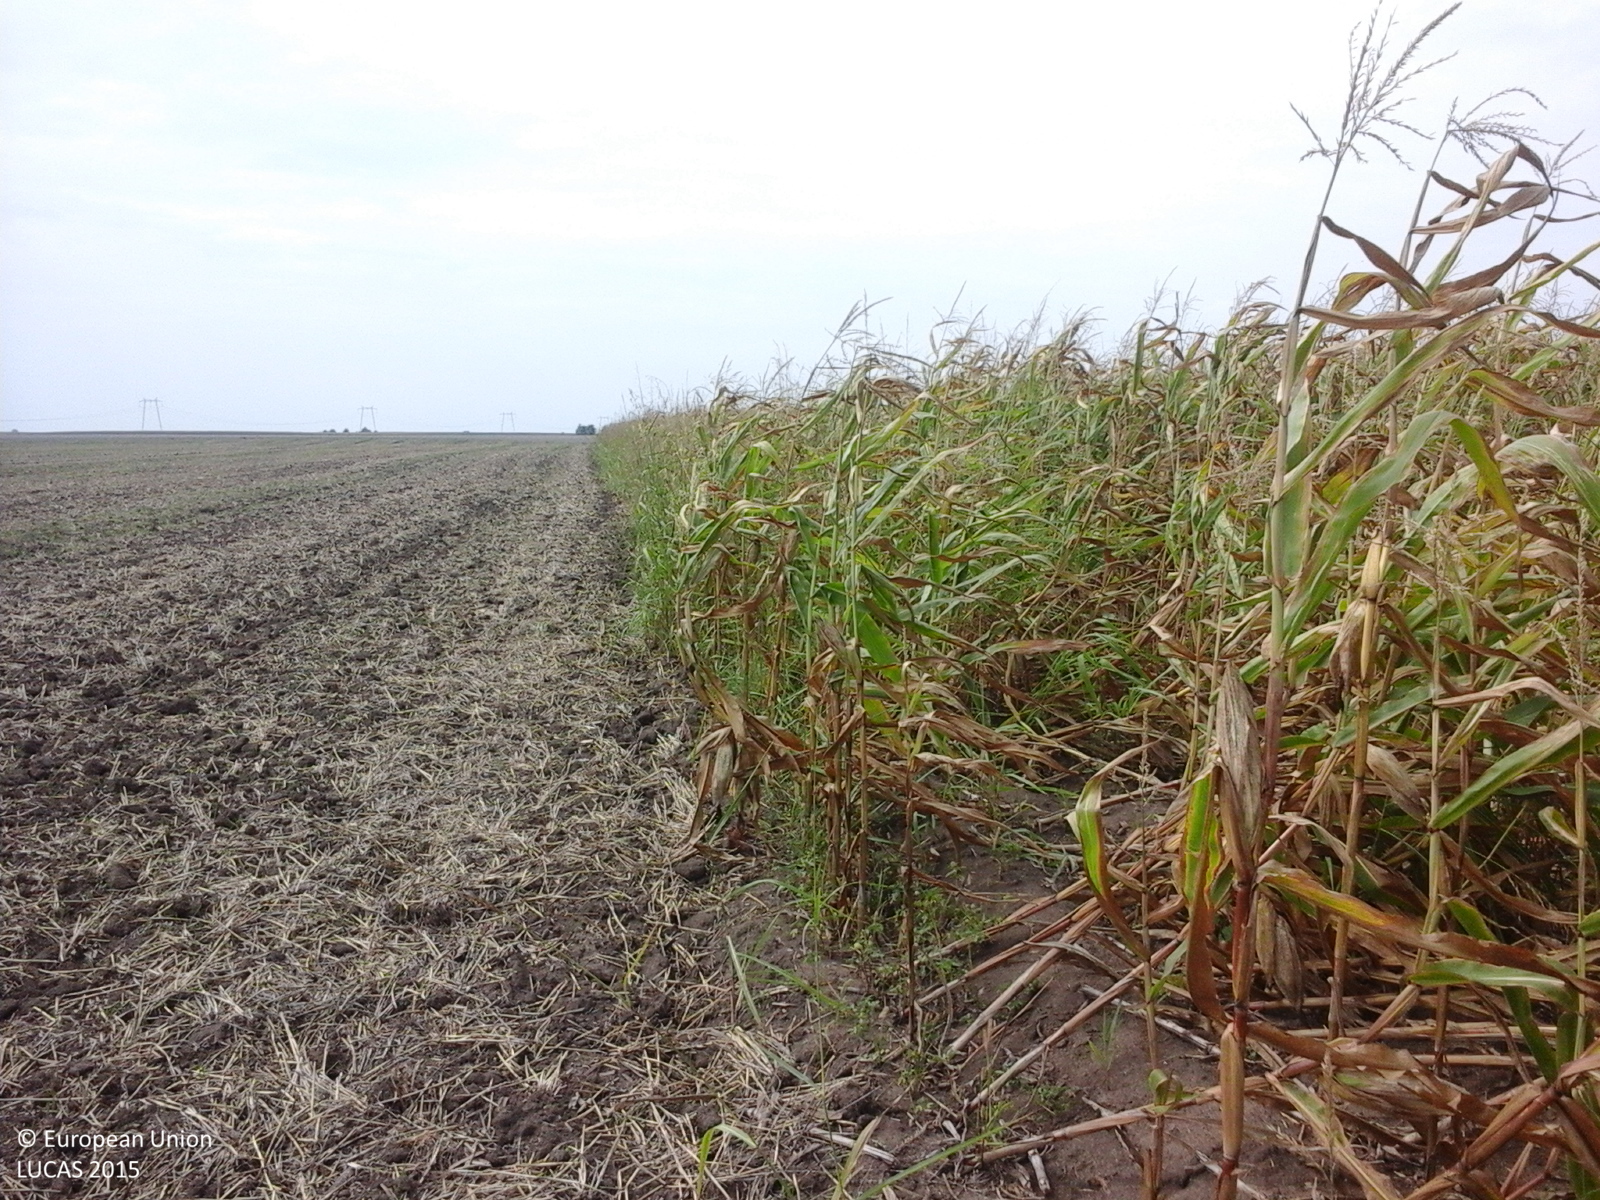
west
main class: Cropland
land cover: Maize
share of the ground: > 75 %
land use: Agriculture (excluding fallow land and kitchen gardens)
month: August
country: RO
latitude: 46.2303
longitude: 20.8820
